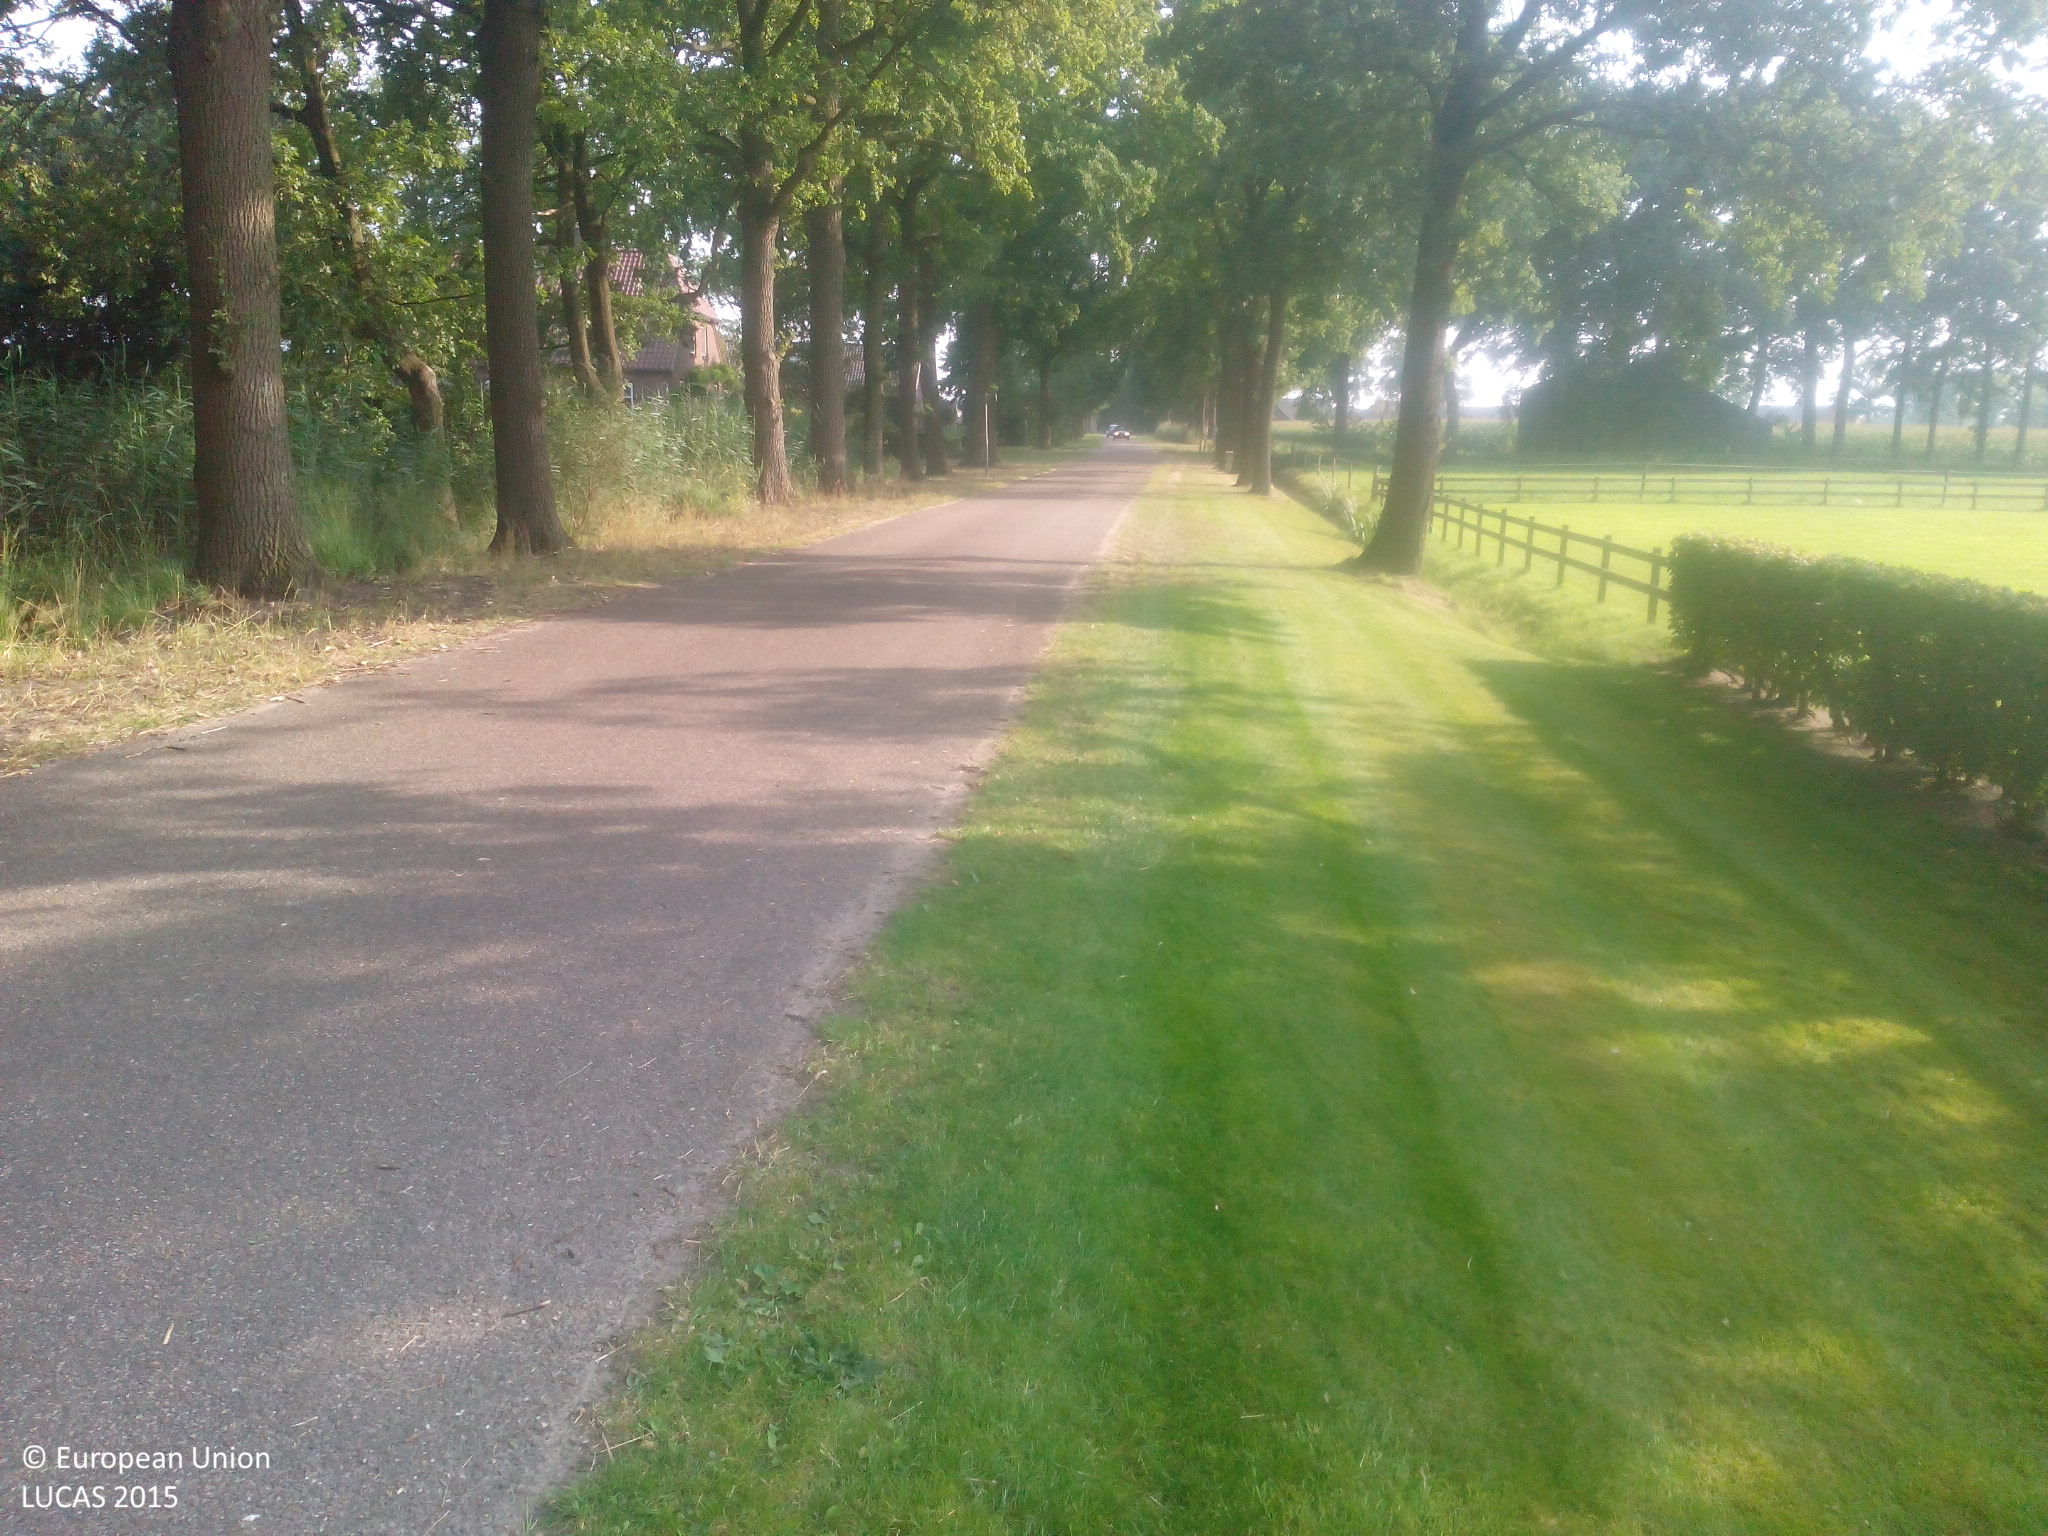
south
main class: Grassland
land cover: Grassland with sparse tree/shrub cover
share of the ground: > 75 %
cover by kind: herbaceous plants 95 %, broadleaved forest trees 5 %
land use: Residential
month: August
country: NL
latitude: 51.7160
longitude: 5.4967
